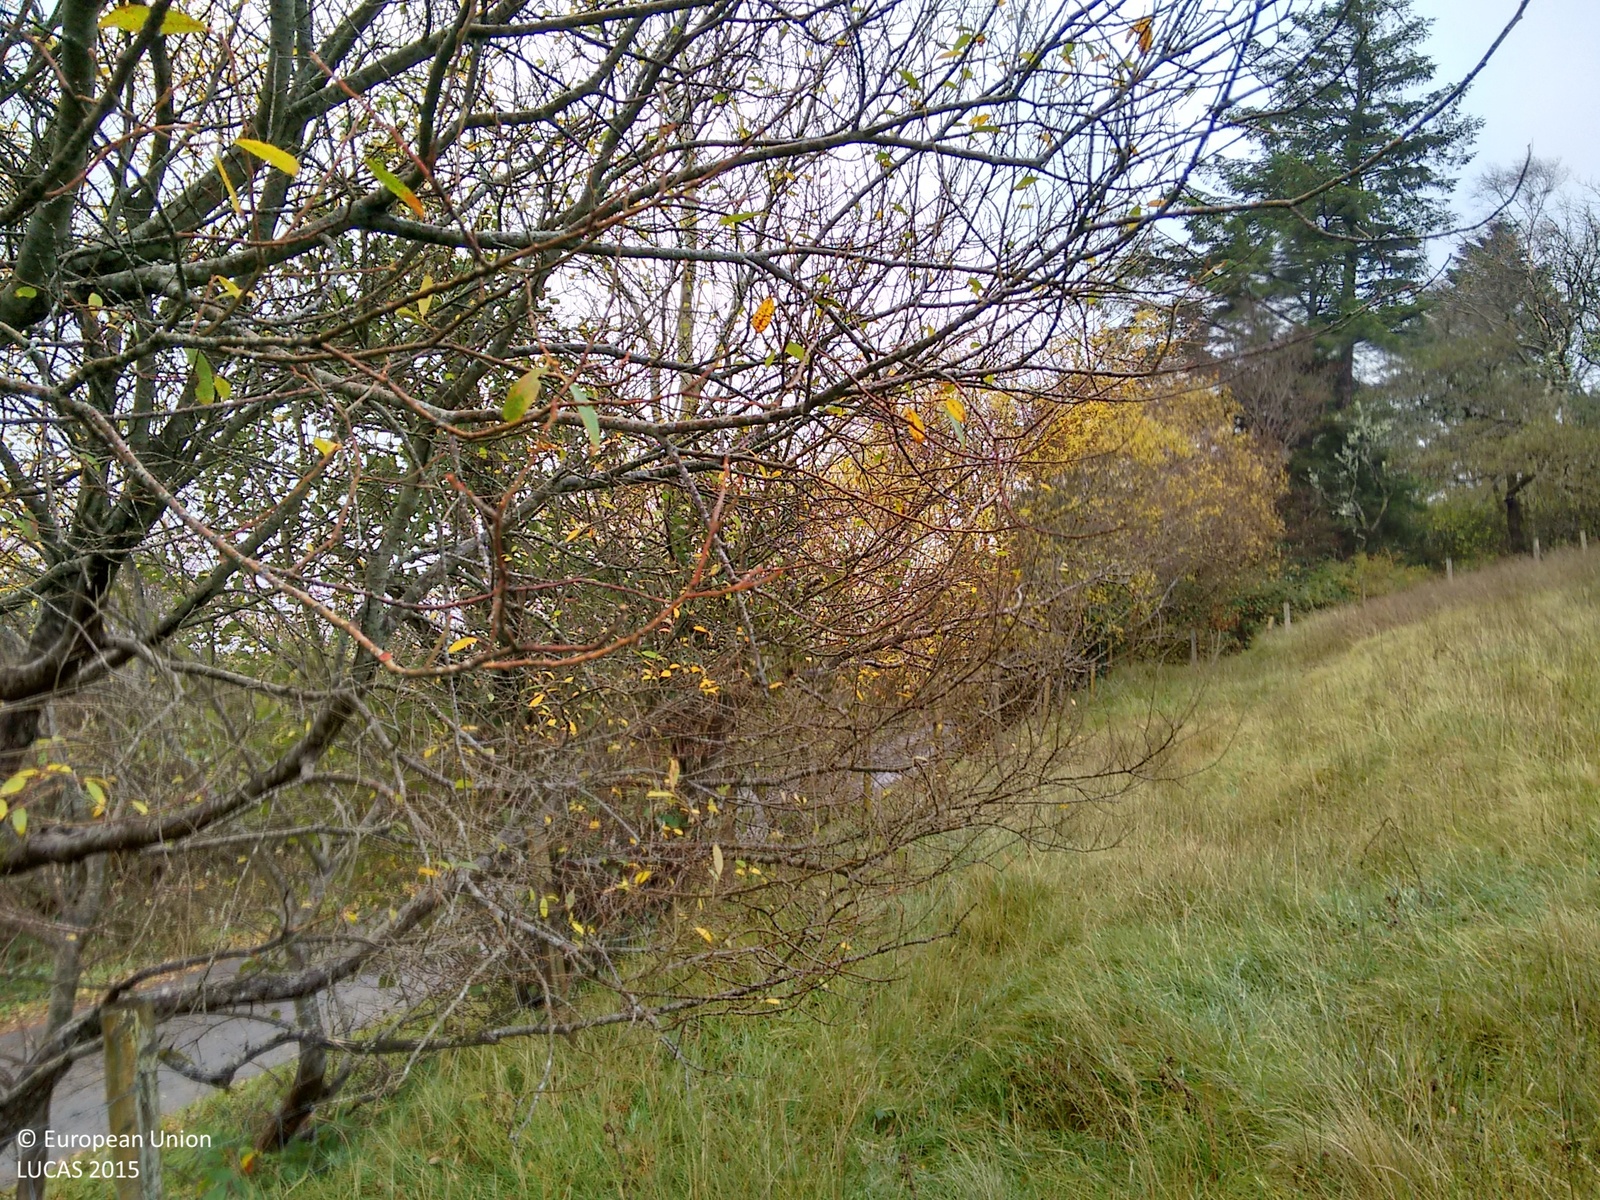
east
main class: Grassland
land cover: Grassland without tree/shrub cover
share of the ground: > 75 %
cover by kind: herbaceous plants 100 %
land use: Agriculture (excluding fallow land and kitchen gardens)
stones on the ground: < 10 %
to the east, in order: Grassland without tree/shrub cover; Fences; Abandoned hedges; Ditches and canals; Grass margins; Paved roads, cycling and walking lanes; Grass margins; Abandoned hedges; Grassland with sparse tree/shrub cover; Grassland without tree/shrub cover; Abandoned hedges; Rivers and streams; Grassland with sparse tree/shrub cover; Broadleaved woodland
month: November
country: IE
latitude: 54.4123
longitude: -8.1605
